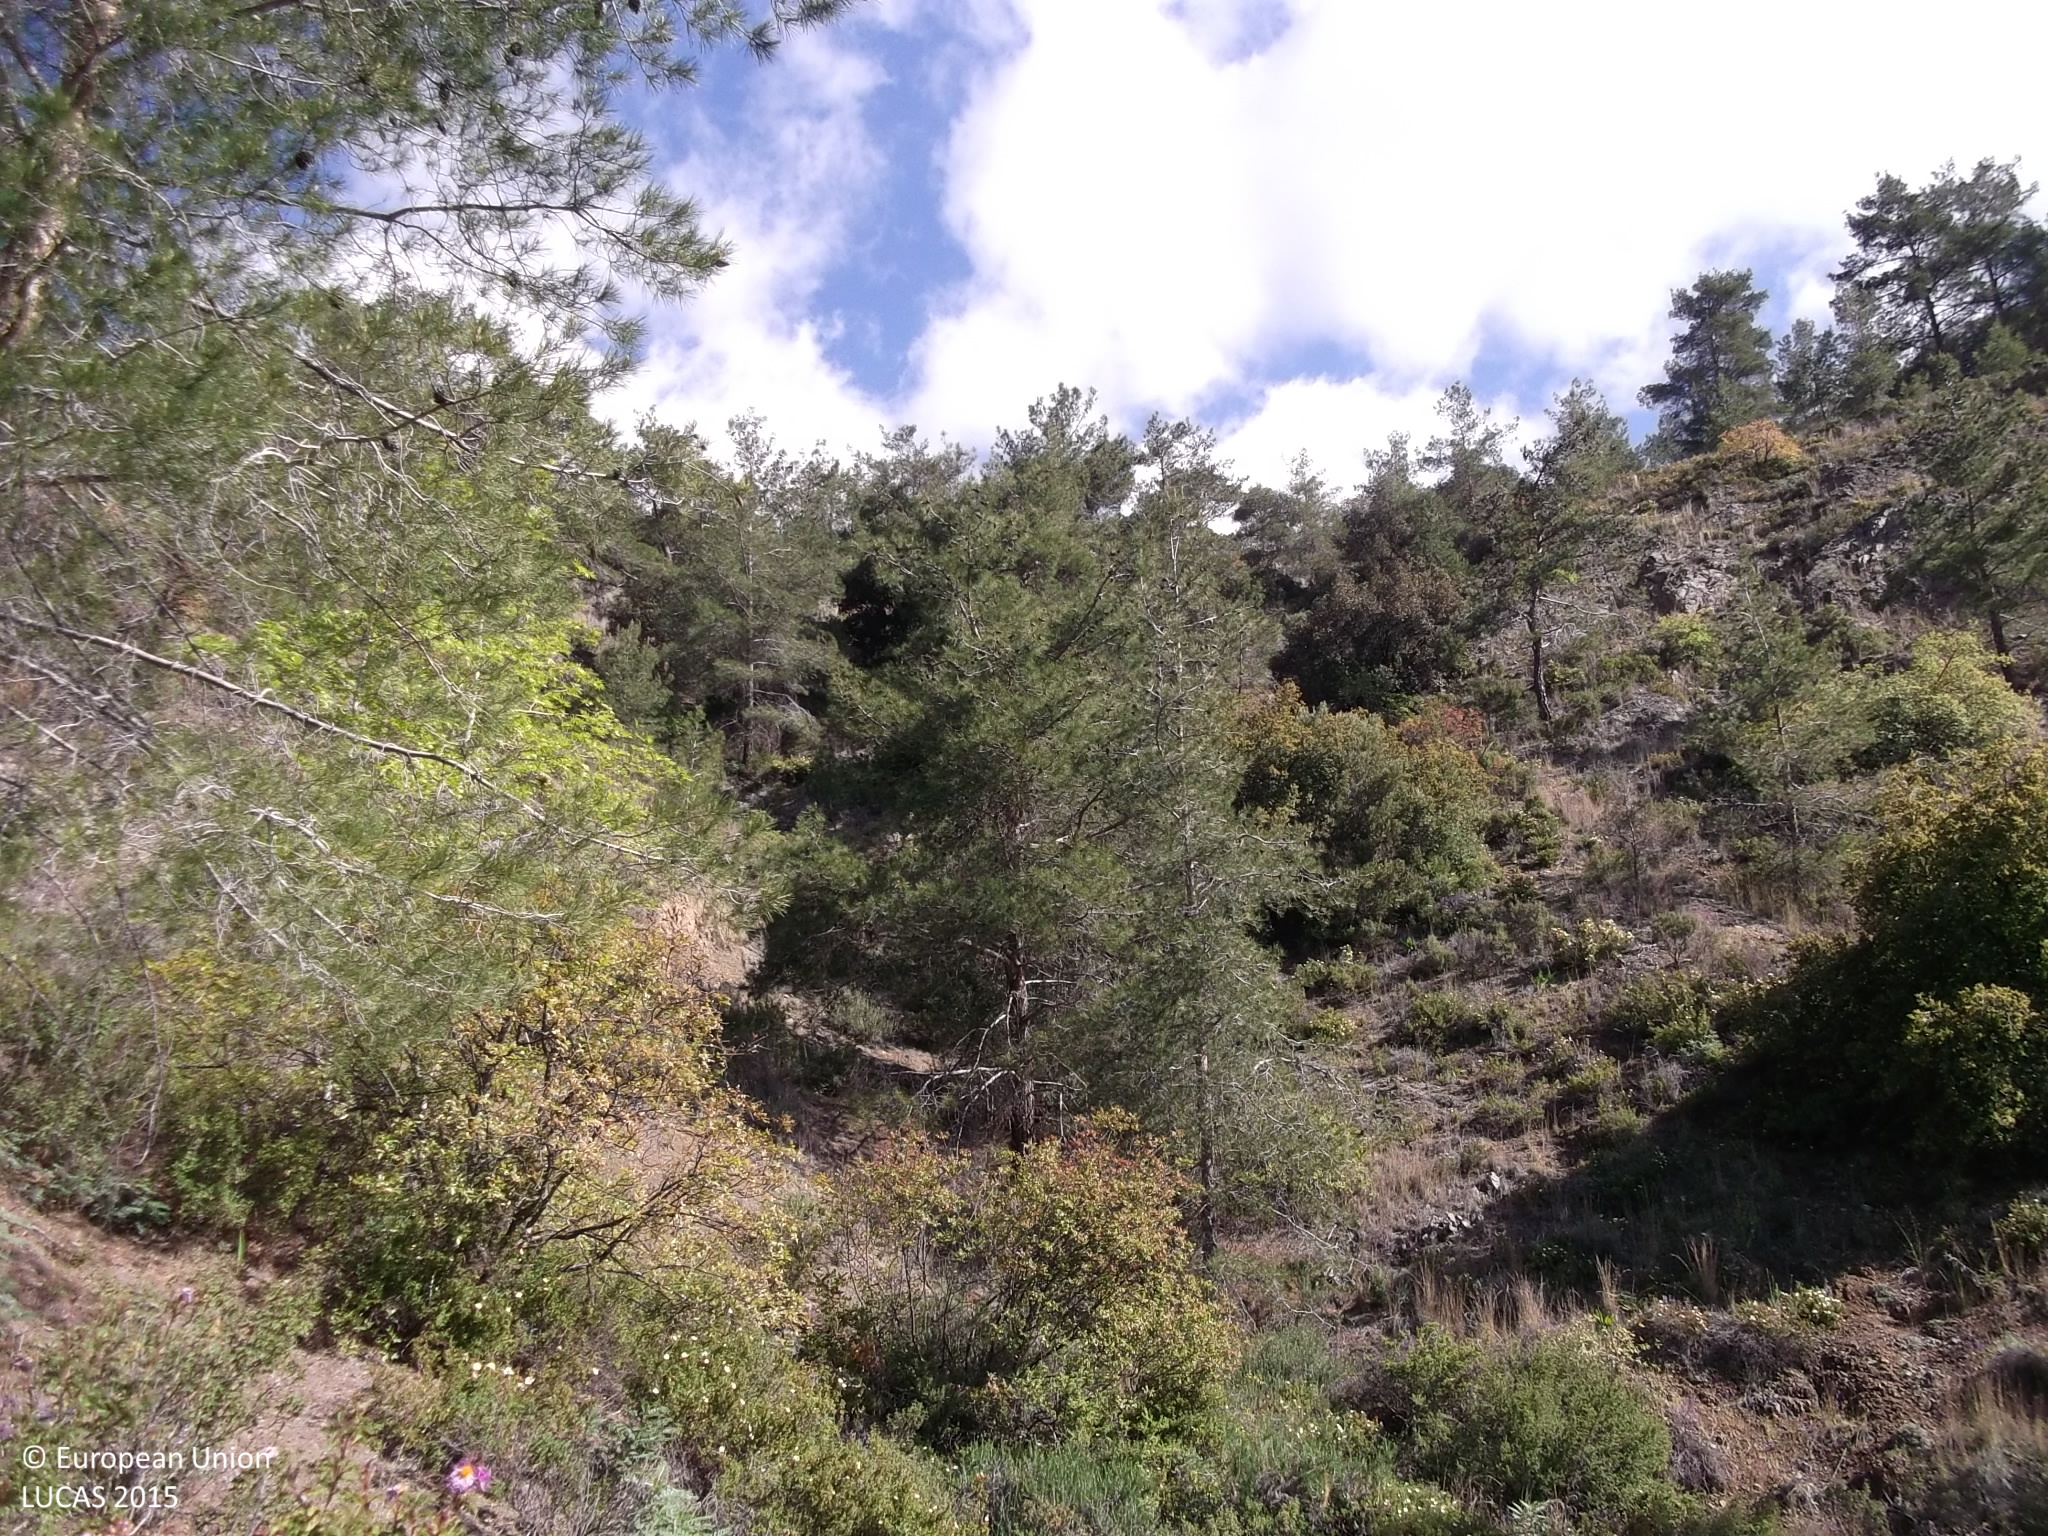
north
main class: Woodland
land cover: Pine dominated coniferous woodland
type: coniferous forest of the mediterranean region
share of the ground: 25 - 50 %
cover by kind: shrubs 50 %, coniferous forest trees 30 %, consolidated bare surface 10 %, unconsolidated bare surface 10 %
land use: Semi-natural and natural areas not in use
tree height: > 5 m
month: April
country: CY
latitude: 34.8821
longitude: 33.0952
